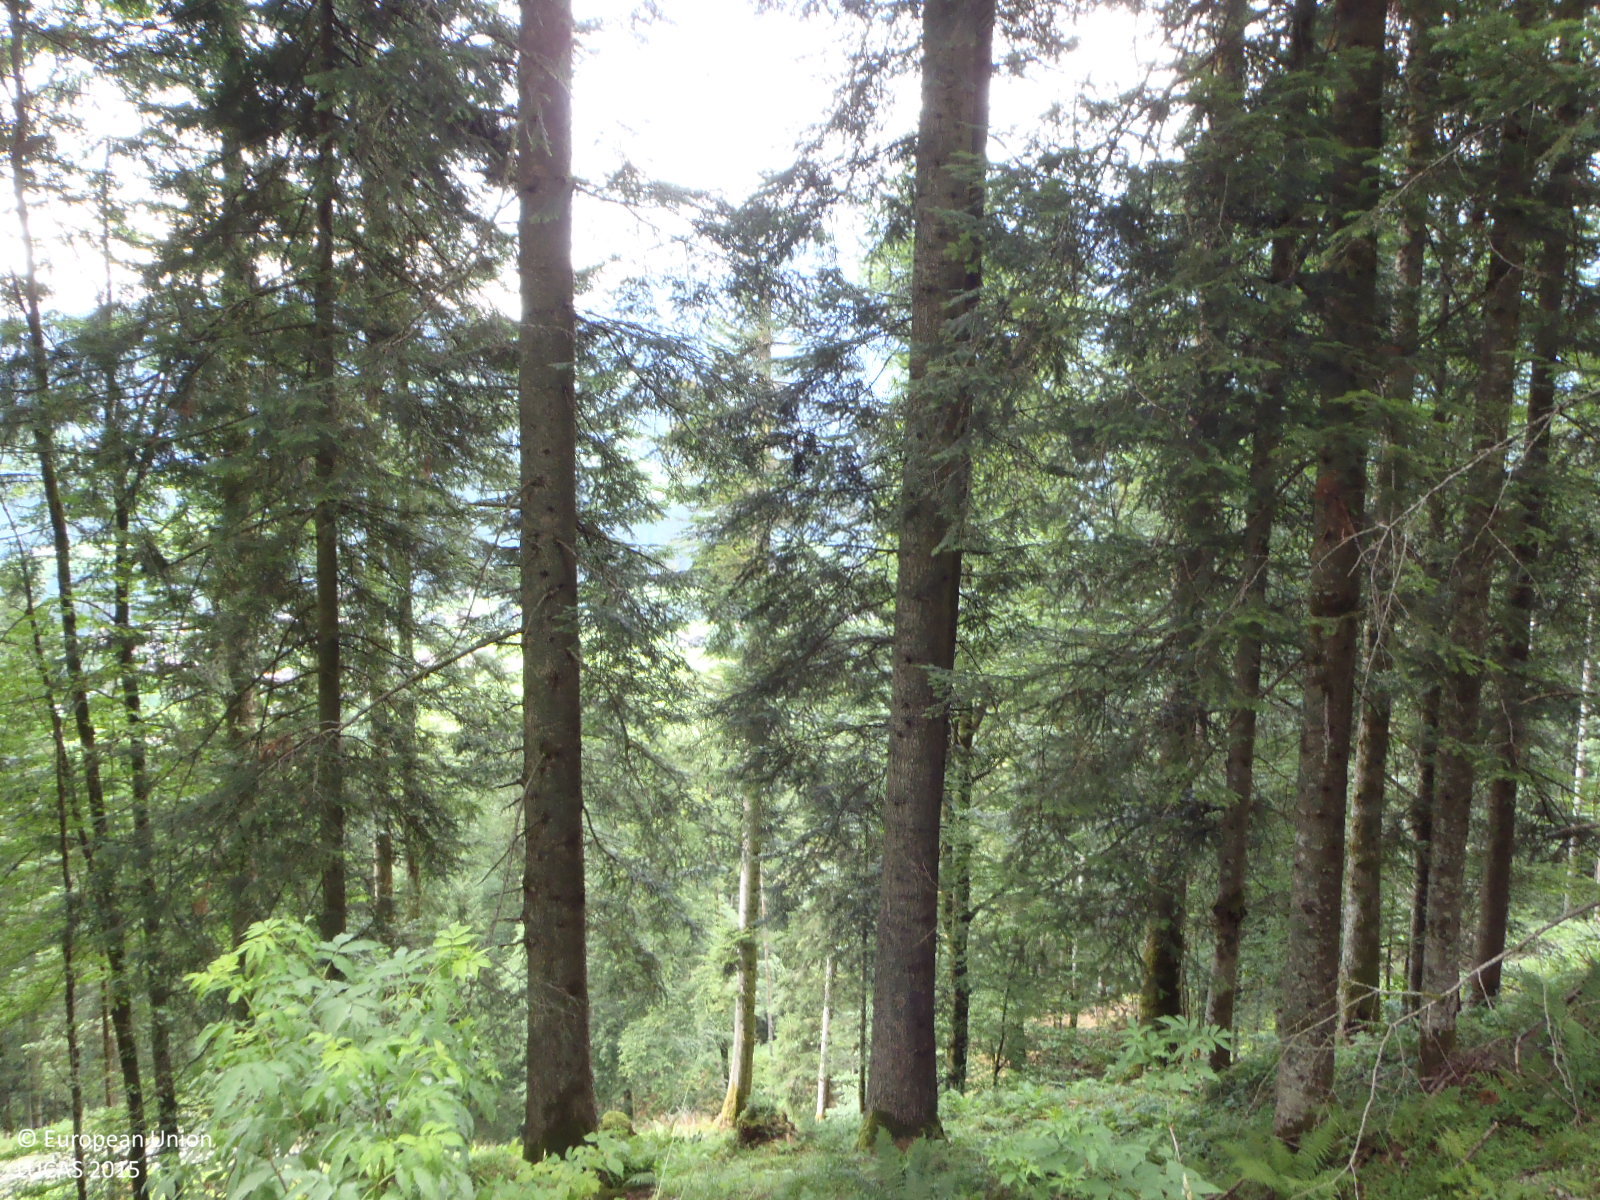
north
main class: Grassland
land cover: Grassland without tree/shrub cover
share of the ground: > 75 %
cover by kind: herbaceous plants 100 %
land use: Agriculture (excluding fallow land and kitchen gardens)
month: July
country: AT
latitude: 47.4991
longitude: 12.2153
